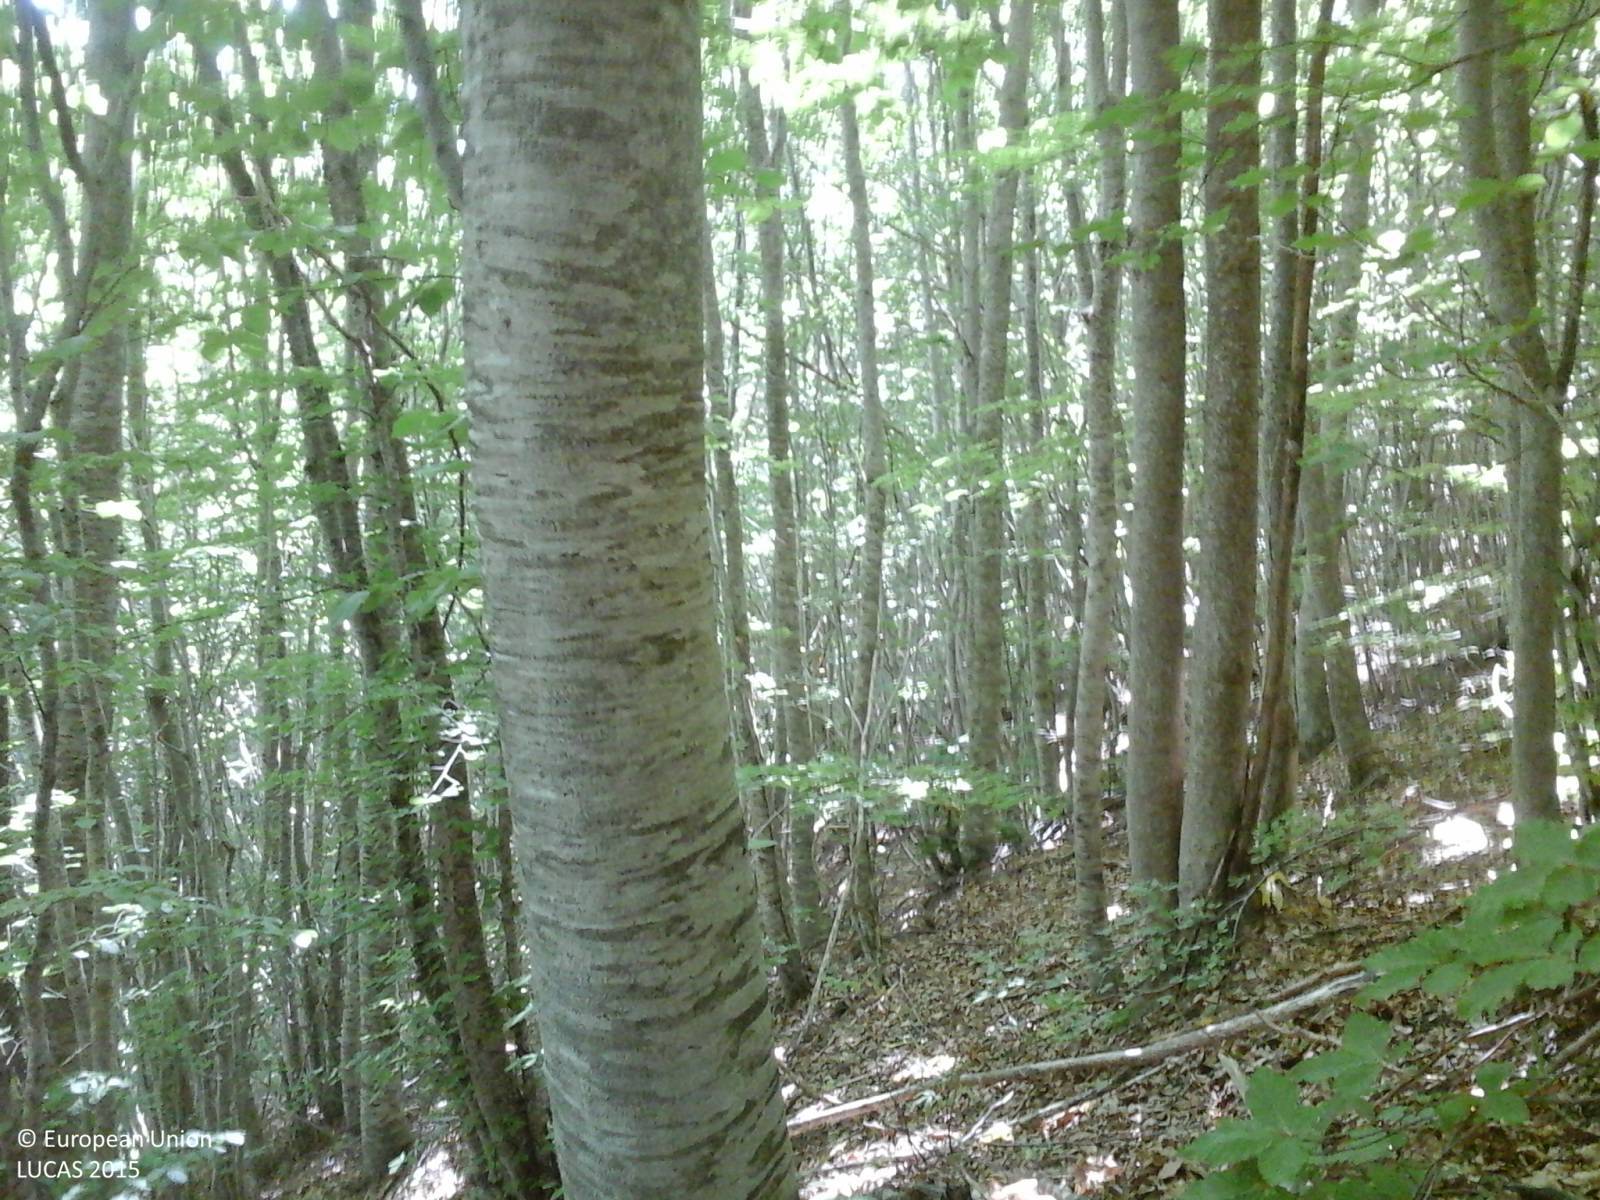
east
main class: Woodland
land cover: Broadleaved woodland
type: mountainous beech forest
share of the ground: > 75 %
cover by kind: broadleaved forest trees 100 %
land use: Semi-natural and natural areas not in use
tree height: > 5 m
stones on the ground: < 10 %
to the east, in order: Broadleaved woodland
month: July
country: IT
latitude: 42.5243
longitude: 13.4101
